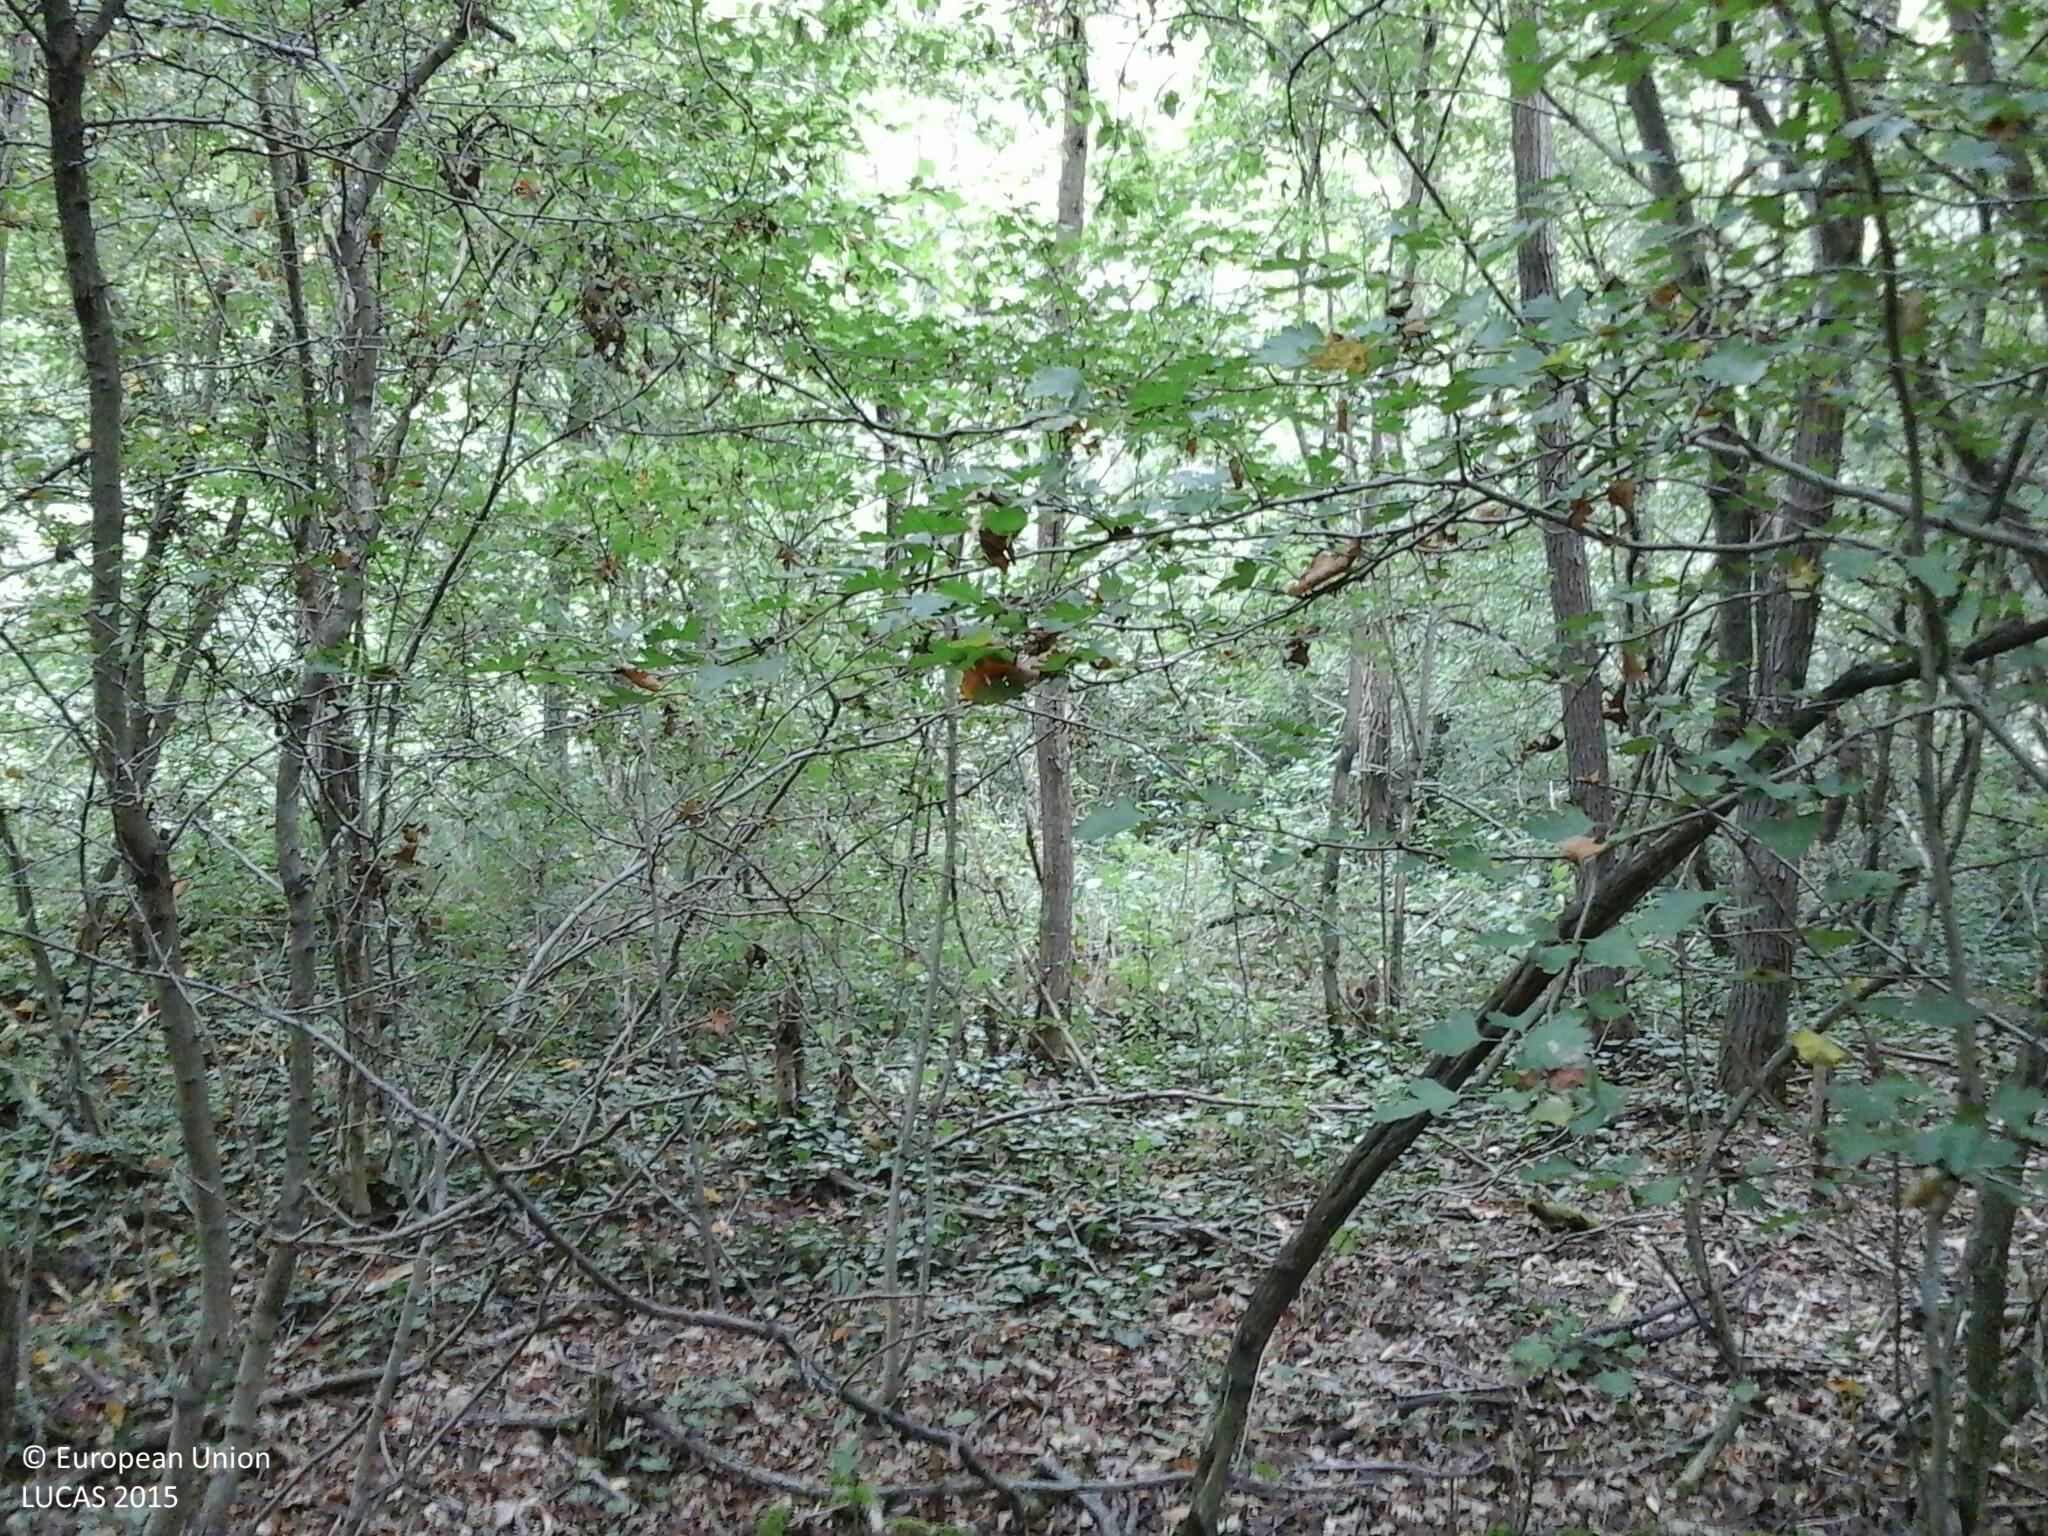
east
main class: Woodland
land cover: Broadleaved woodland
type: thermophilous deciduous forest
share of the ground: > 75 %
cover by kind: broadleaved forest trees 100 %
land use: Forestry
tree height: > 5 m
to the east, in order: Broadleaved woodland; Ditches and canals; Tracks; Ditches and canals; Broadleaved woodland; Tracks; Other bare soil; Electric lines; Other bare soil
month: August
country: HU
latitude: 45.8323
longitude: 18.2584
